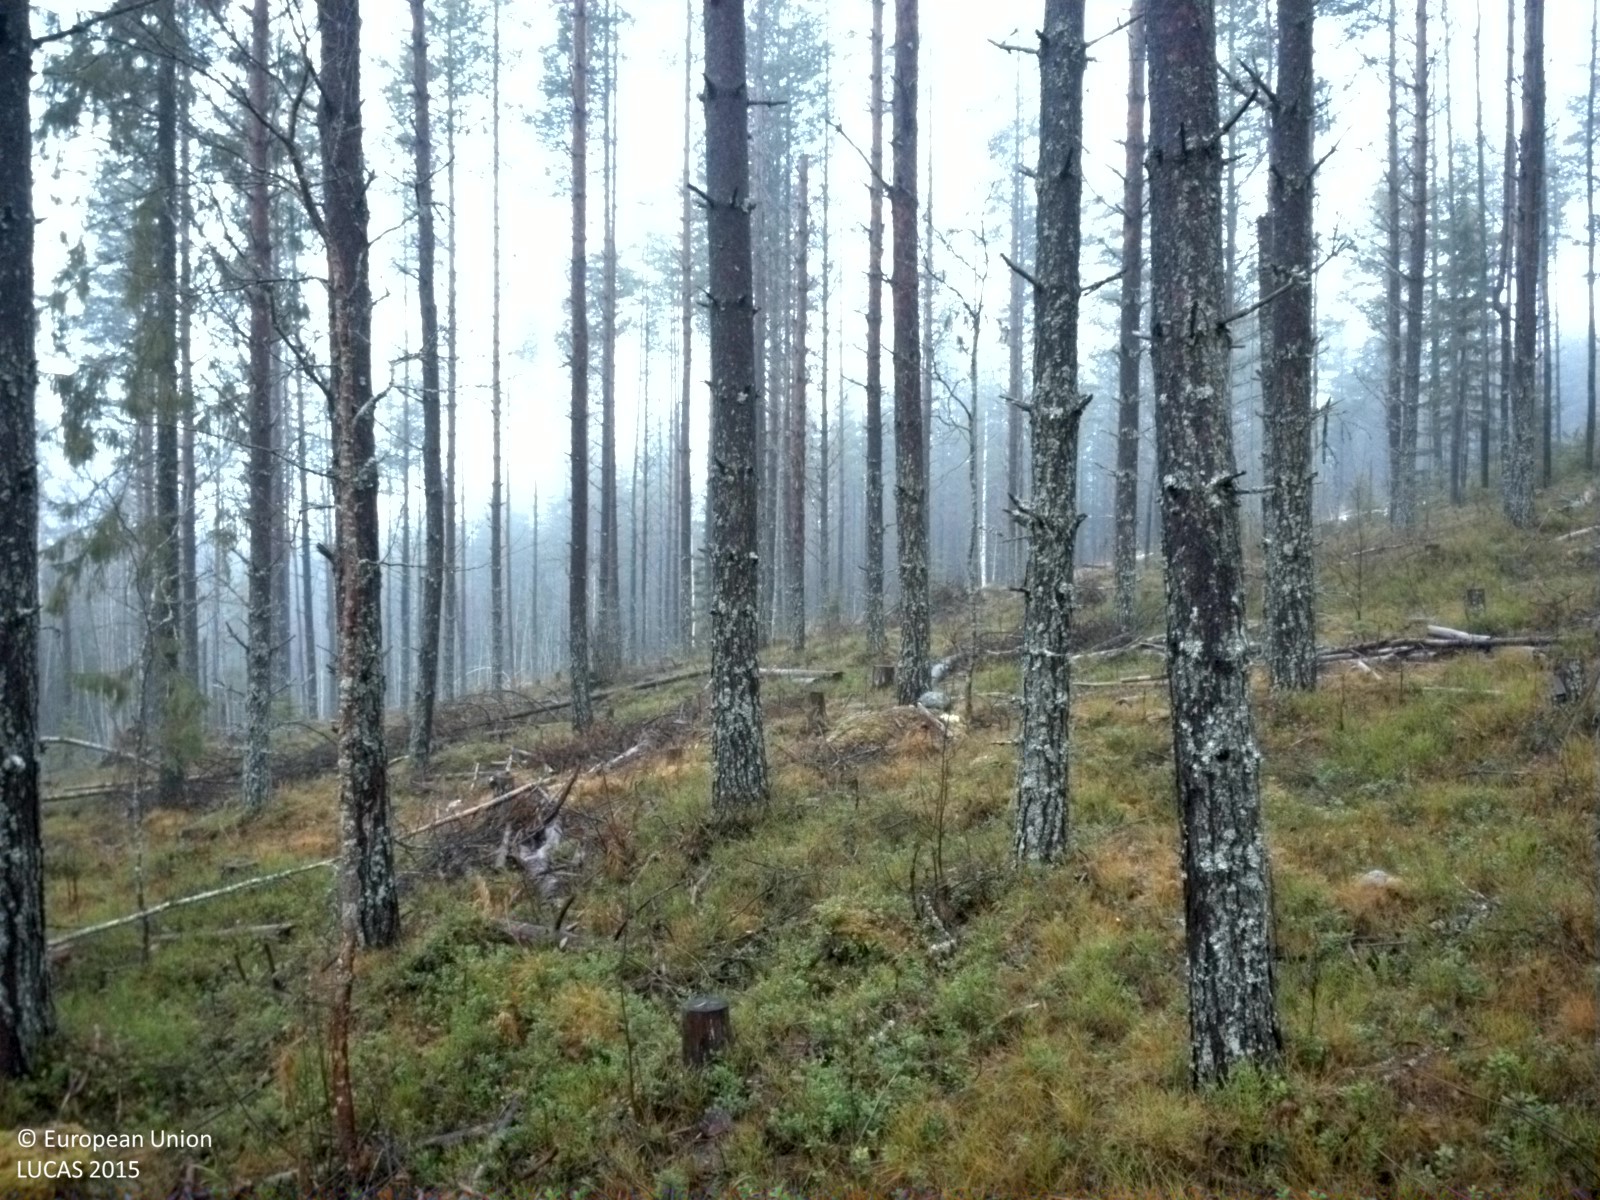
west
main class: Woodland
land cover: Pine dominated coniferous woodland
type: boreal forest
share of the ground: 25 - 50 %
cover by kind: shrubs 40 %, coniferous forest trees 35 %, lichens and mosses 15 %, broadleaved forest trees 5 %, herbaceous plants 5 %
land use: Forestry
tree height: > 5 m
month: November
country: SE
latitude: 64.0292
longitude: 16.0501
